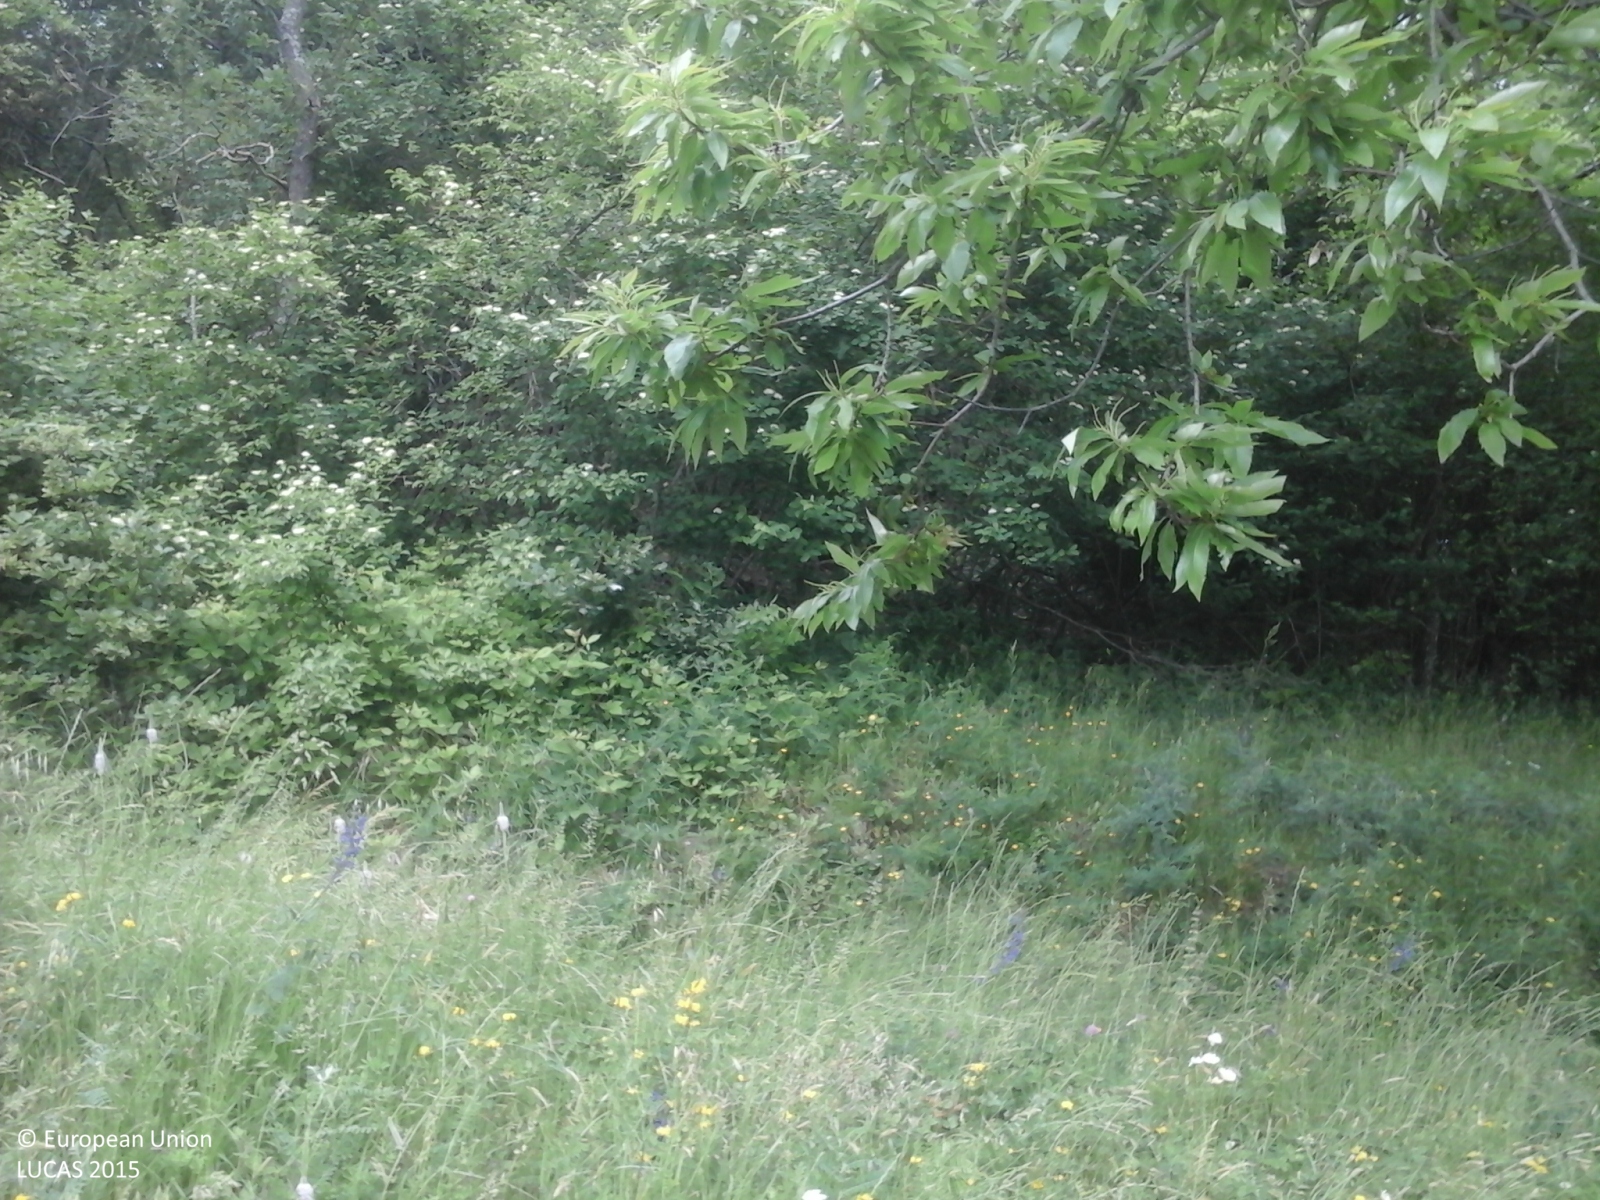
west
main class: Cropland
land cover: Barley
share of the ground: > 75 %
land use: Agriculture (excluding fallow land and kitchen gardens)
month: May
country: IT
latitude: 44.3100
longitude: 10.9631
